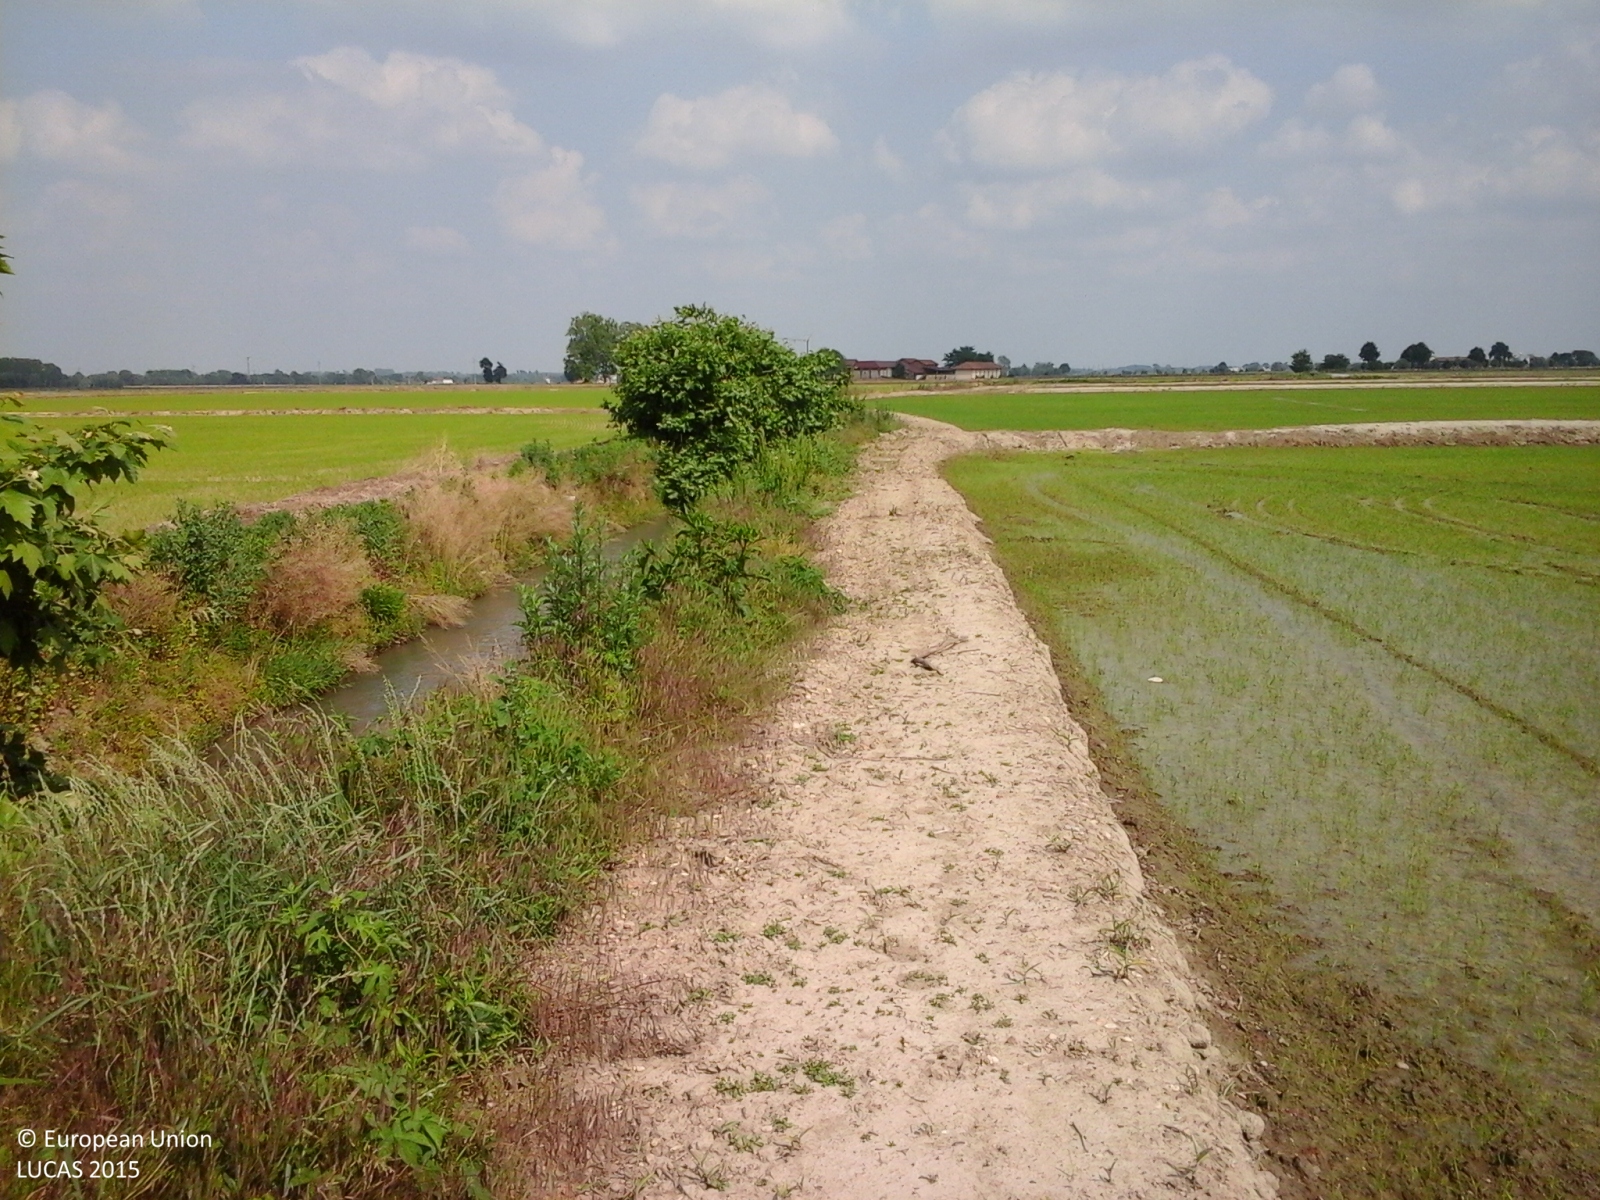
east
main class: Cropland
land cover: Rice
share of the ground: 25 - 50 %
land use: Agriculture (excluding fallow land and kitchen gardens)
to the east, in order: Rice; Other structural elements; Rice; Grass margins; Inland fresh running water; Grass margins; Rice; Ditches and canals; Rice
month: May
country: IT
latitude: 45.3830
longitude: 8.3298
